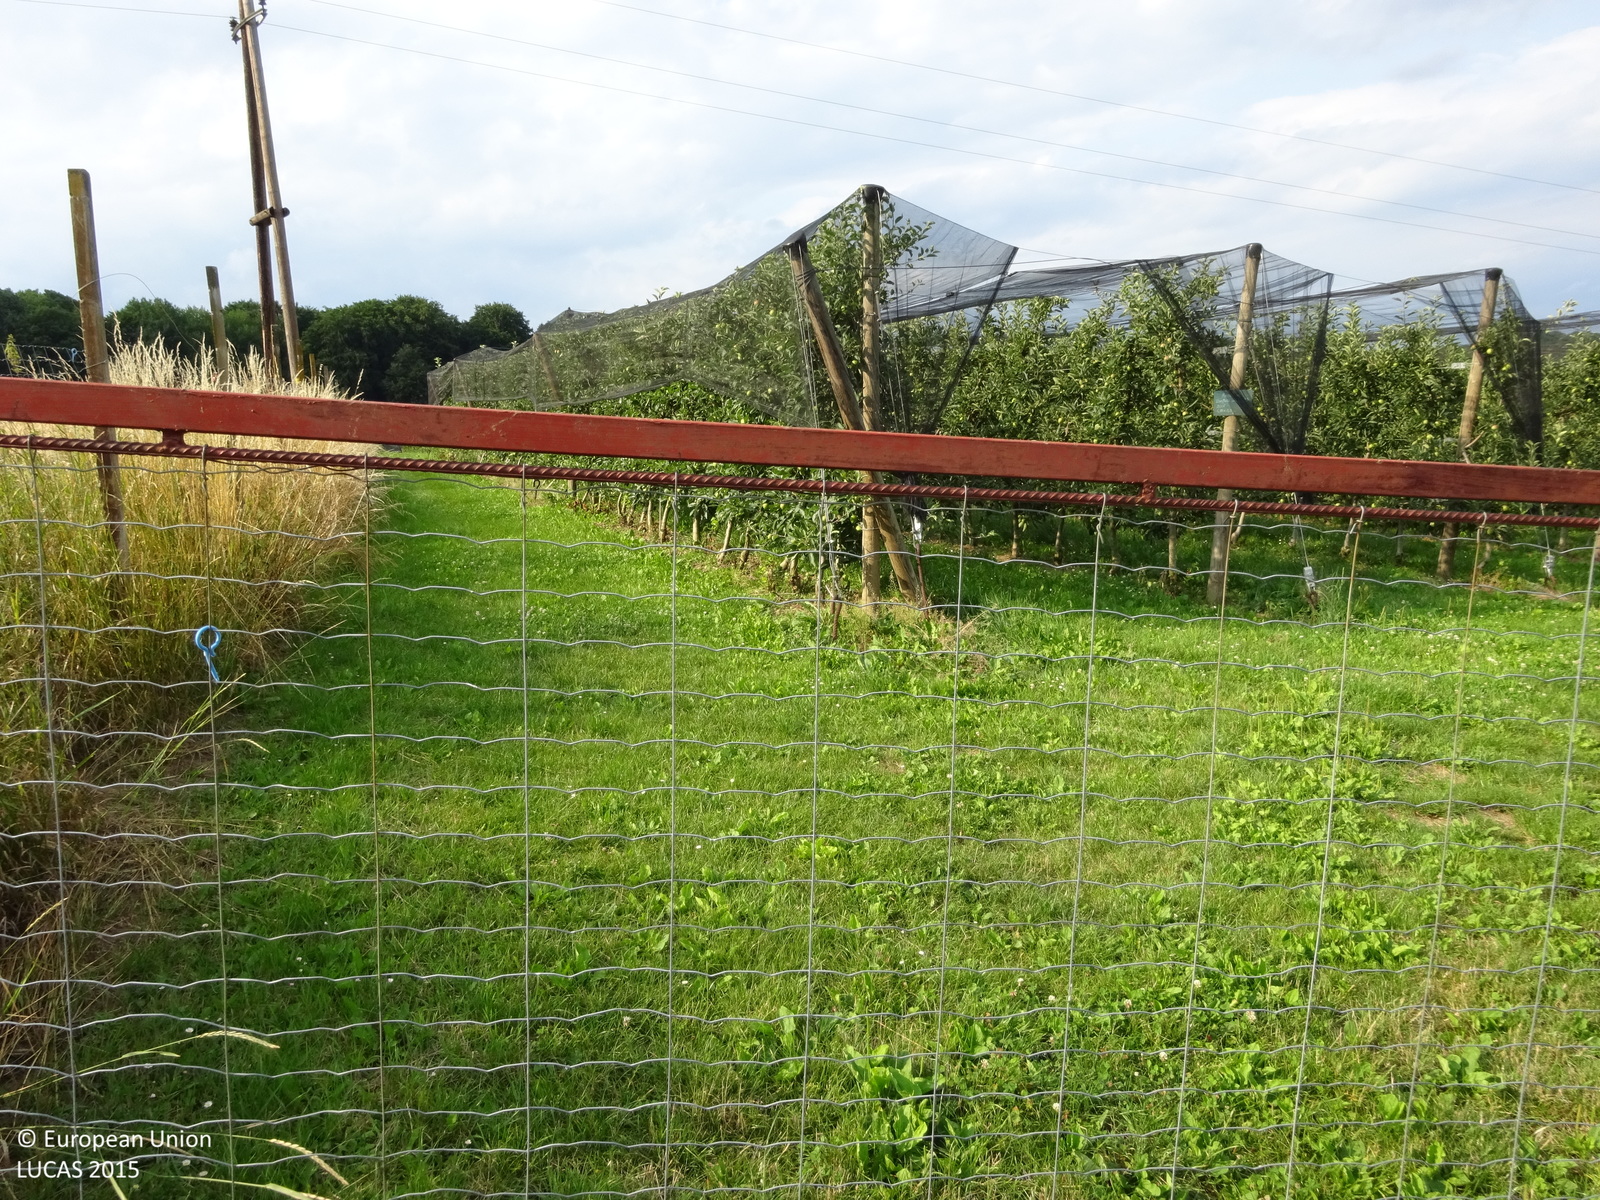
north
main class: Cropland
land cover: Apple fruit
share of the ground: > 75 %
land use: Agriculture (excluding fallow land and kitchen gardens)
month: June
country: AT
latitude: 46.8003
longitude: 15.9358
